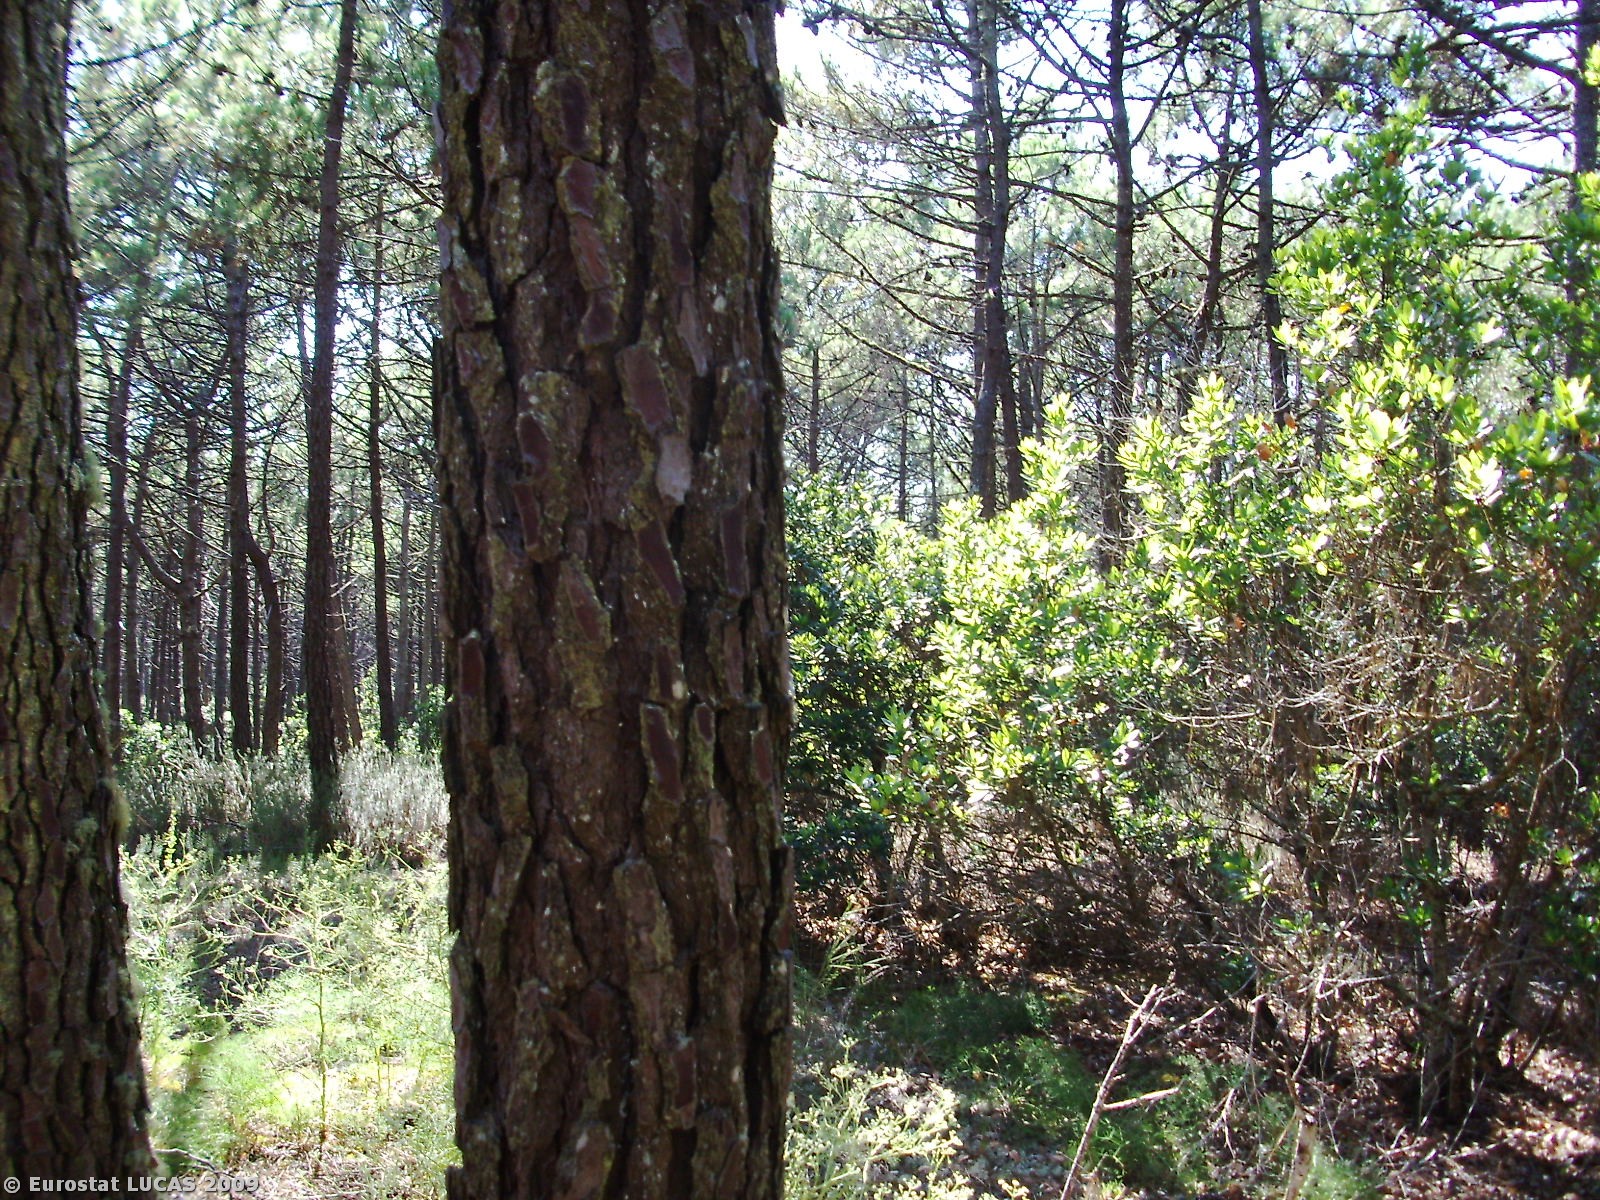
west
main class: Woodland
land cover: Coniferous woodland
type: coniferous forest of the mediterranean region
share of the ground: > 75 %
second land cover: Shrubland with sparse tree cover
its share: 10 - 25 %
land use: Forestry
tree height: > 5 m
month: August
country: PT
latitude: 39.9042
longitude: -8.9364
